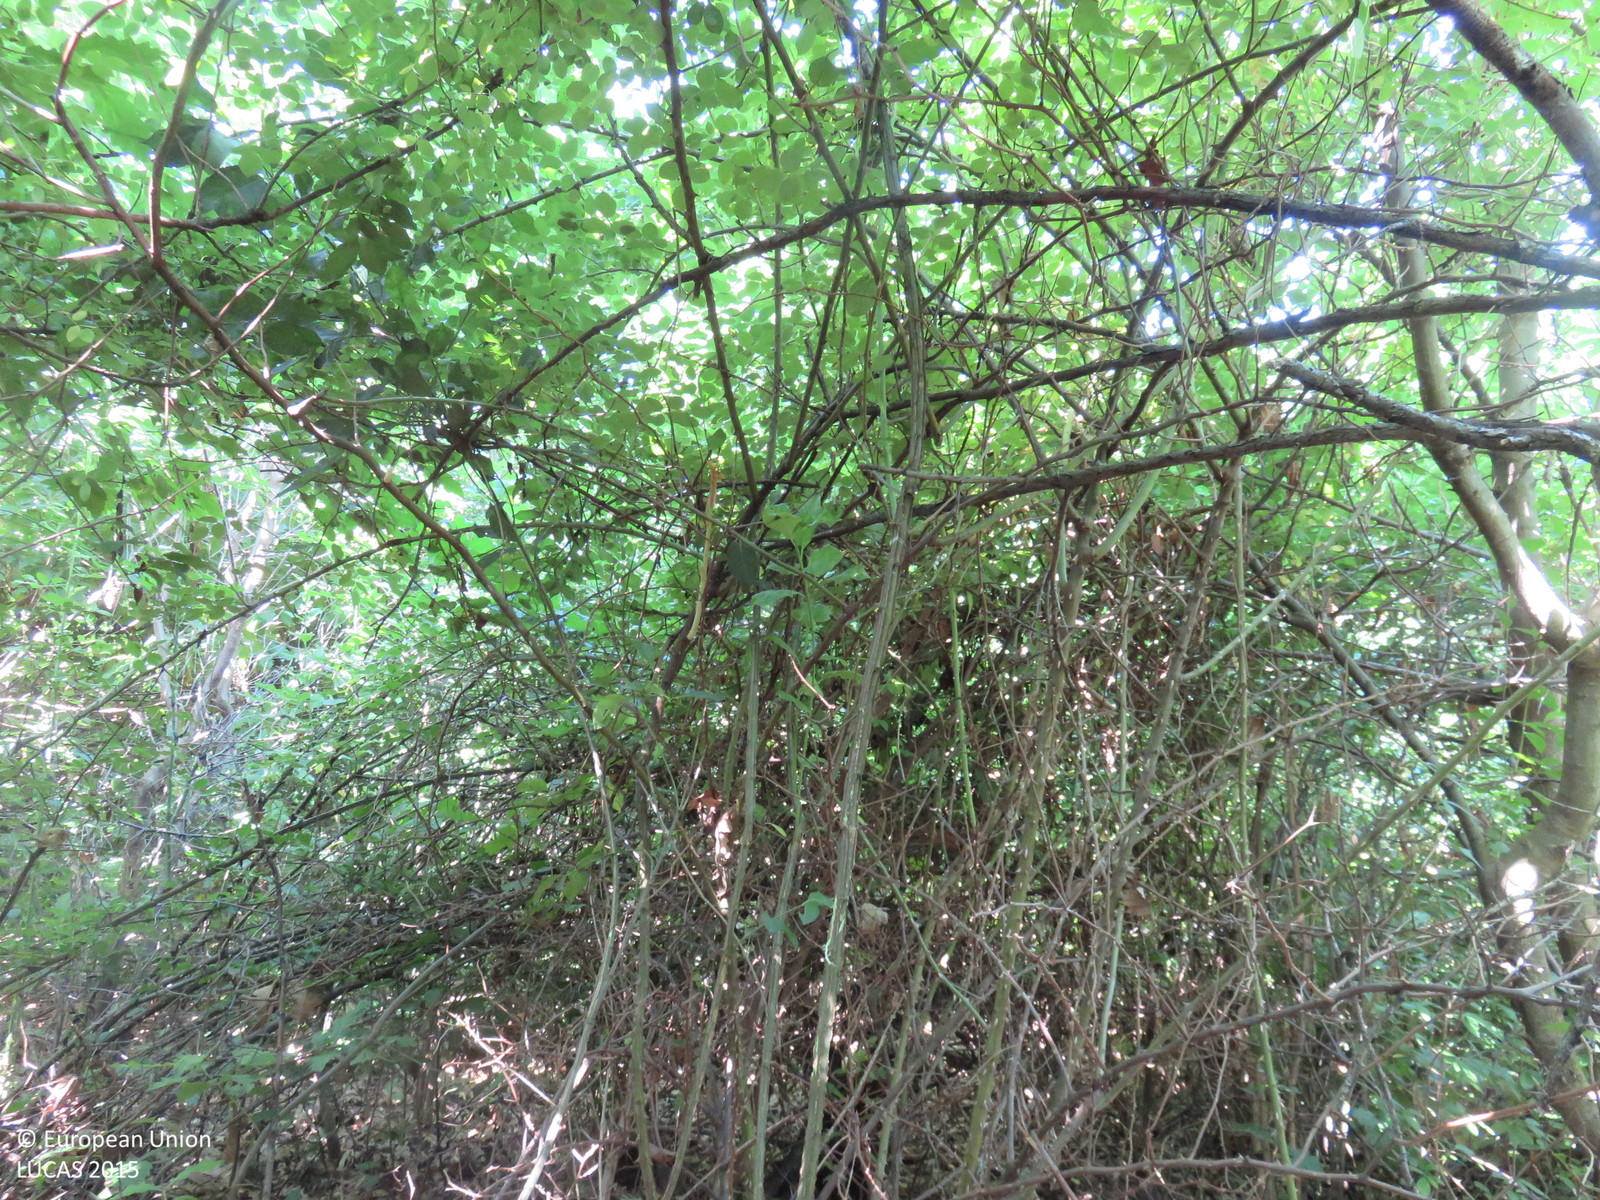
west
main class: Woodland
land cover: Broadleaved woodland
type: mesophytic deciduous forest
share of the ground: > 75 %
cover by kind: broadleaved forest trees 75 %, shrubs 25 %
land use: Semi-natural and natural areas not in use
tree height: < 5 m
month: June
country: BG
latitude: 43.2376
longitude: 24.8551
